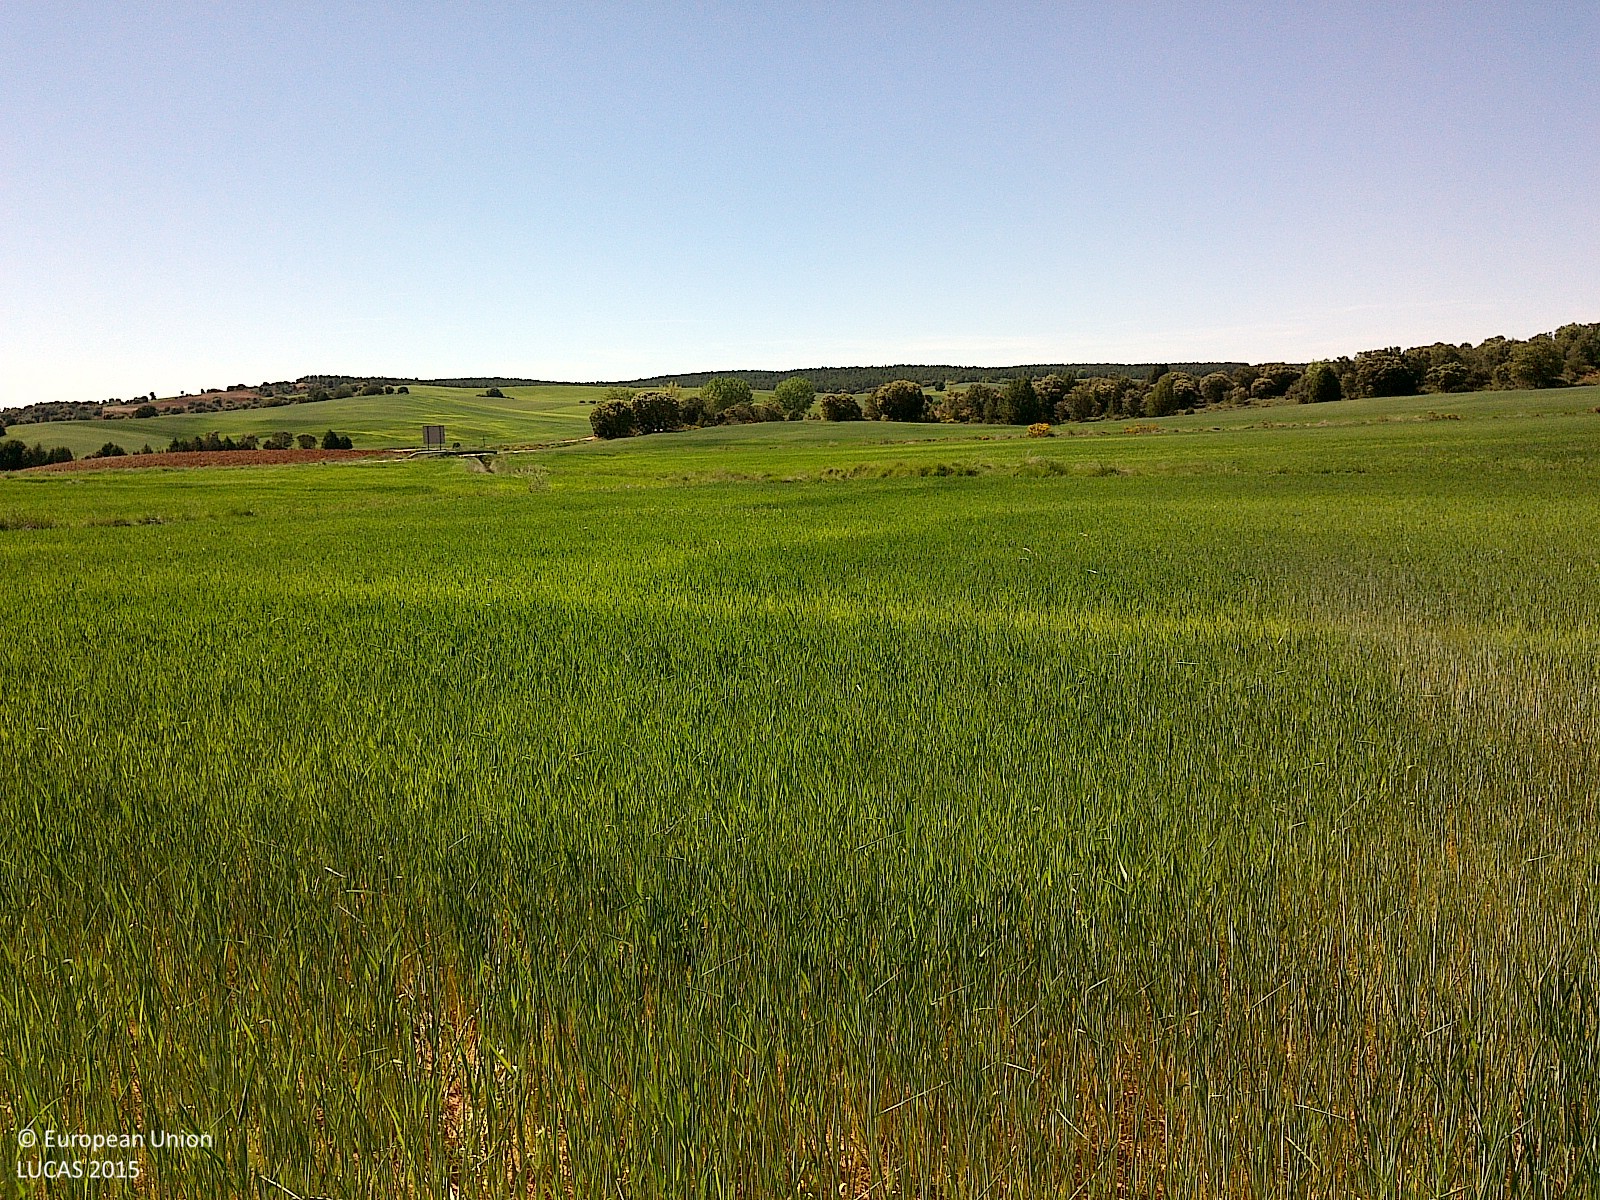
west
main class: Cropland
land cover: Barley
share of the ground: > 75 %
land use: Agriculture (excluding fallow land and kitchen gardens)
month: May
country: ES
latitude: 41.6147
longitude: -3.1129
